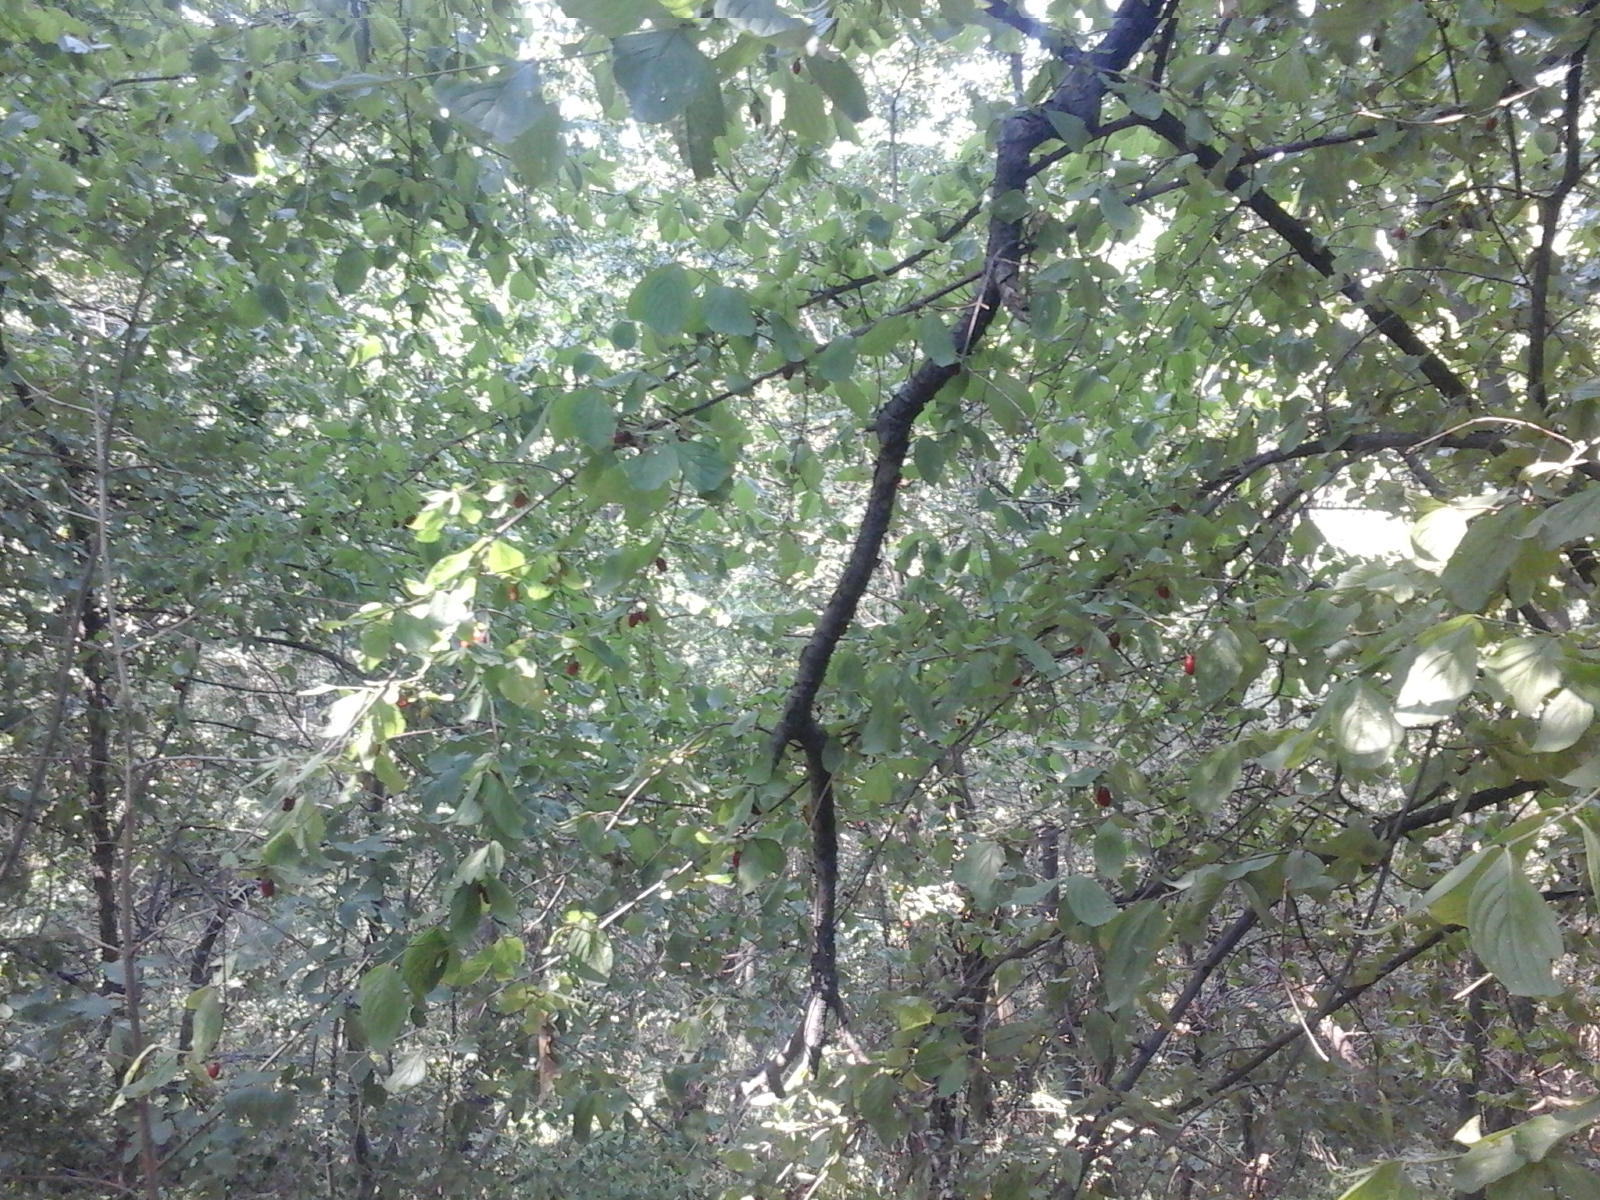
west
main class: Woodland
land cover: Broadleaved woodland
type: acidophilous oak and oak-birch forest
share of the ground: > 75 %
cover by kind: broadleaved forest trees 100 %
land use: Forestry
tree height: > 5 m
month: August
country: RO
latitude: 44.5725
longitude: 23.2597
